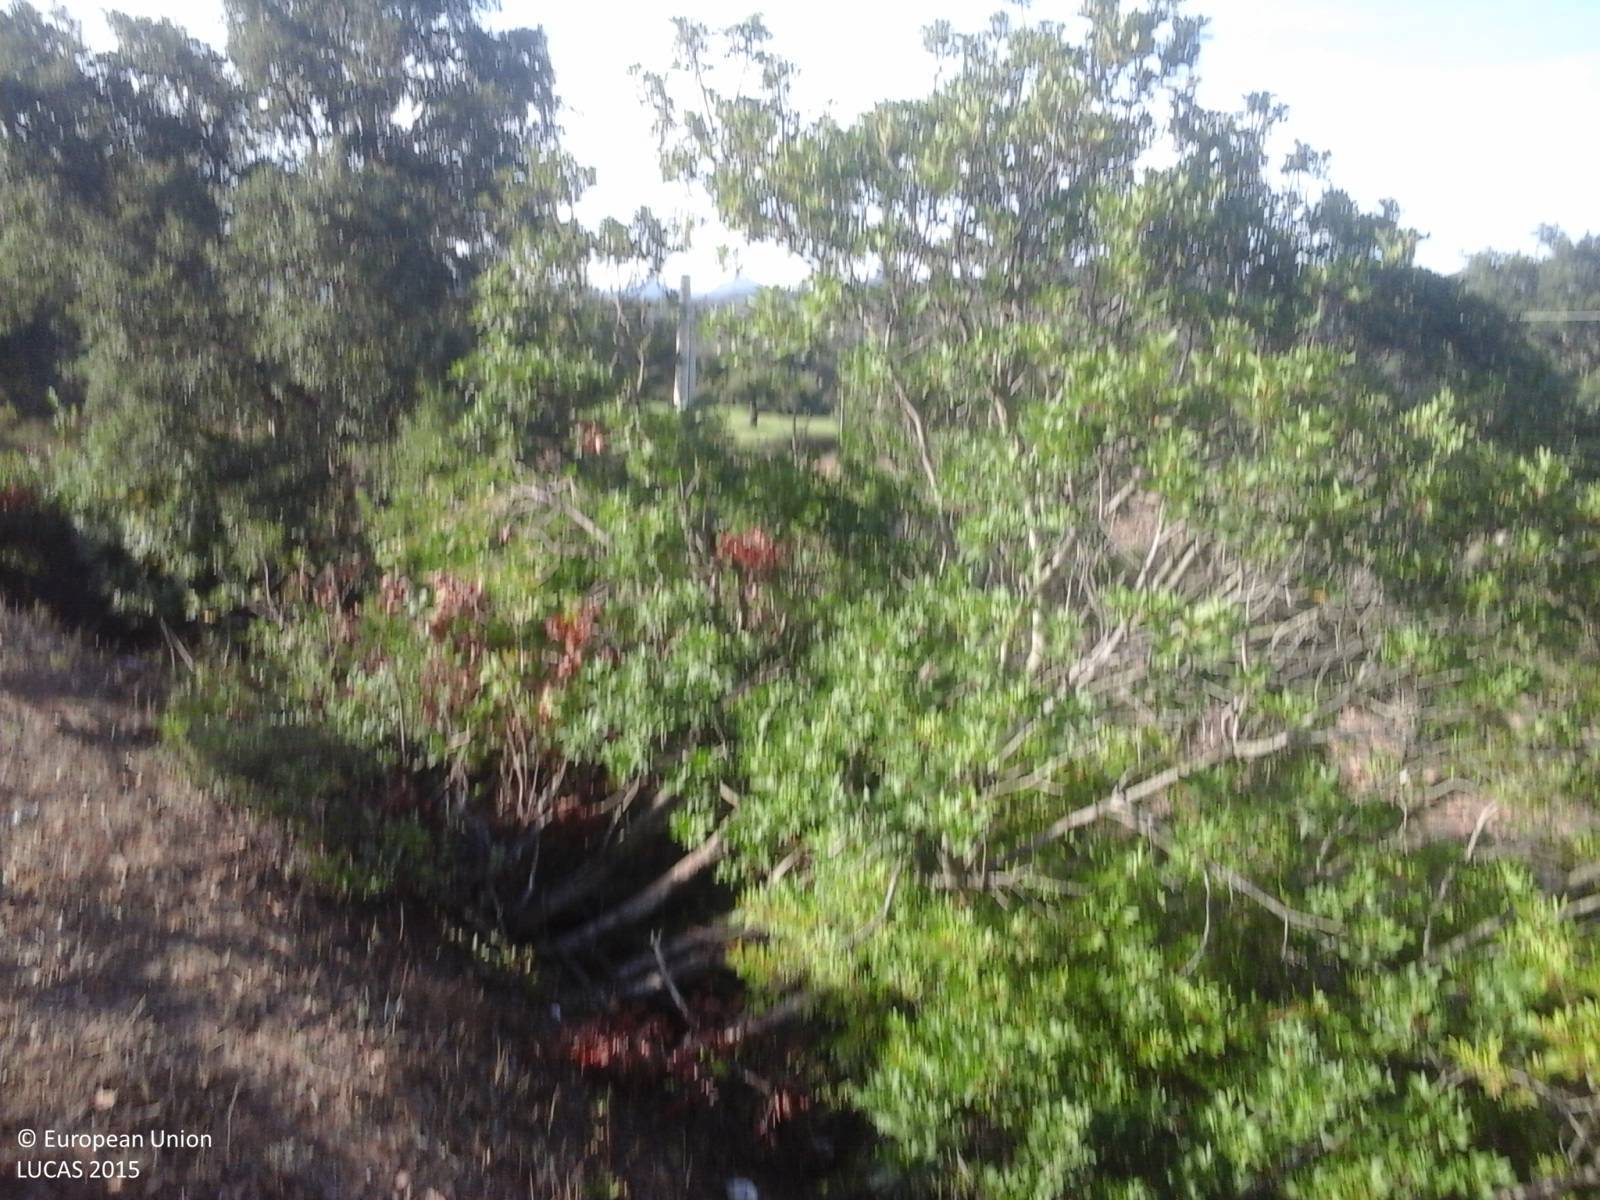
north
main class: Grassland
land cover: Spontaneously vegetated surfaces
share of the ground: > 75 %
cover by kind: unconsolidated bare surface 50 %, herbaceous plants 45 %, consolidated bare surface 5 %
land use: Fallow land
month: September
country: IT
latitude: 39.9406
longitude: 9.5927
